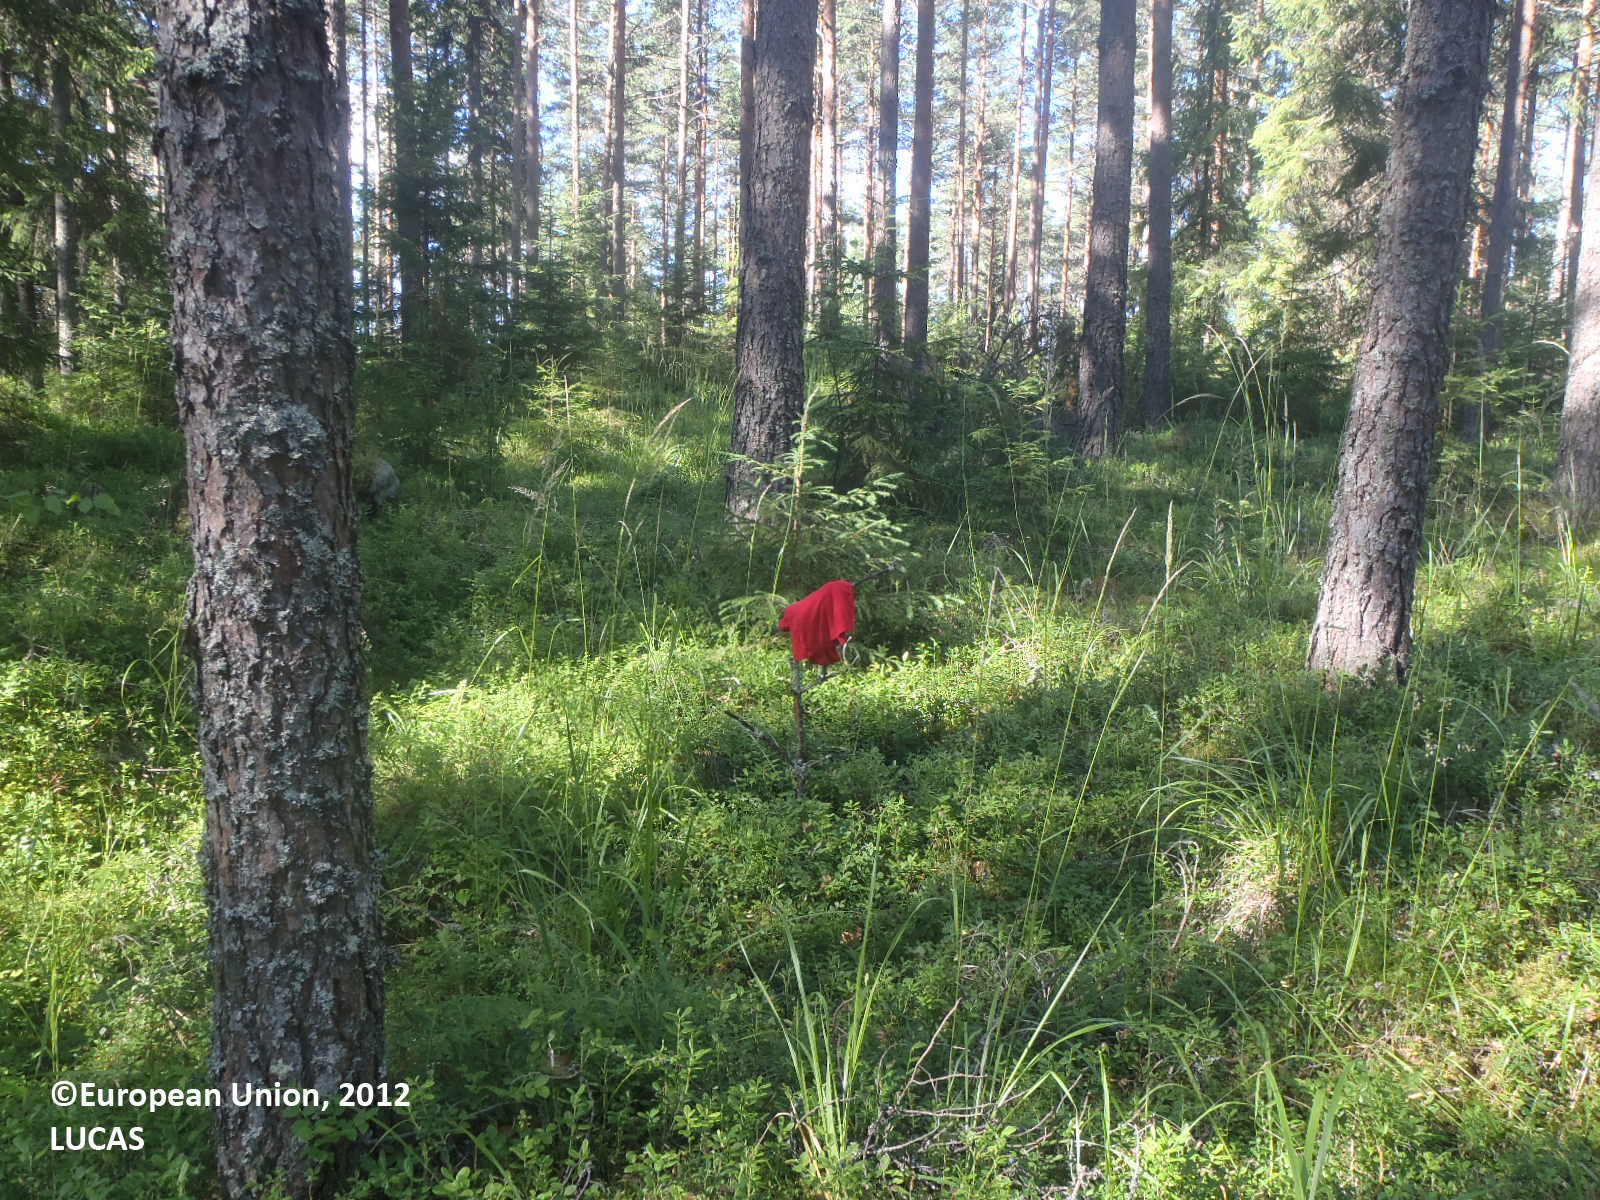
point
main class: Woodland
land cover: Pine dominated coniferous woodland
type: boreal forest
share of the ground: 50 - 75 %
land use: Forestry
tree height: > 5 m
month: July
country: FI
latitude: 61.0732
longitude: 21.9762
